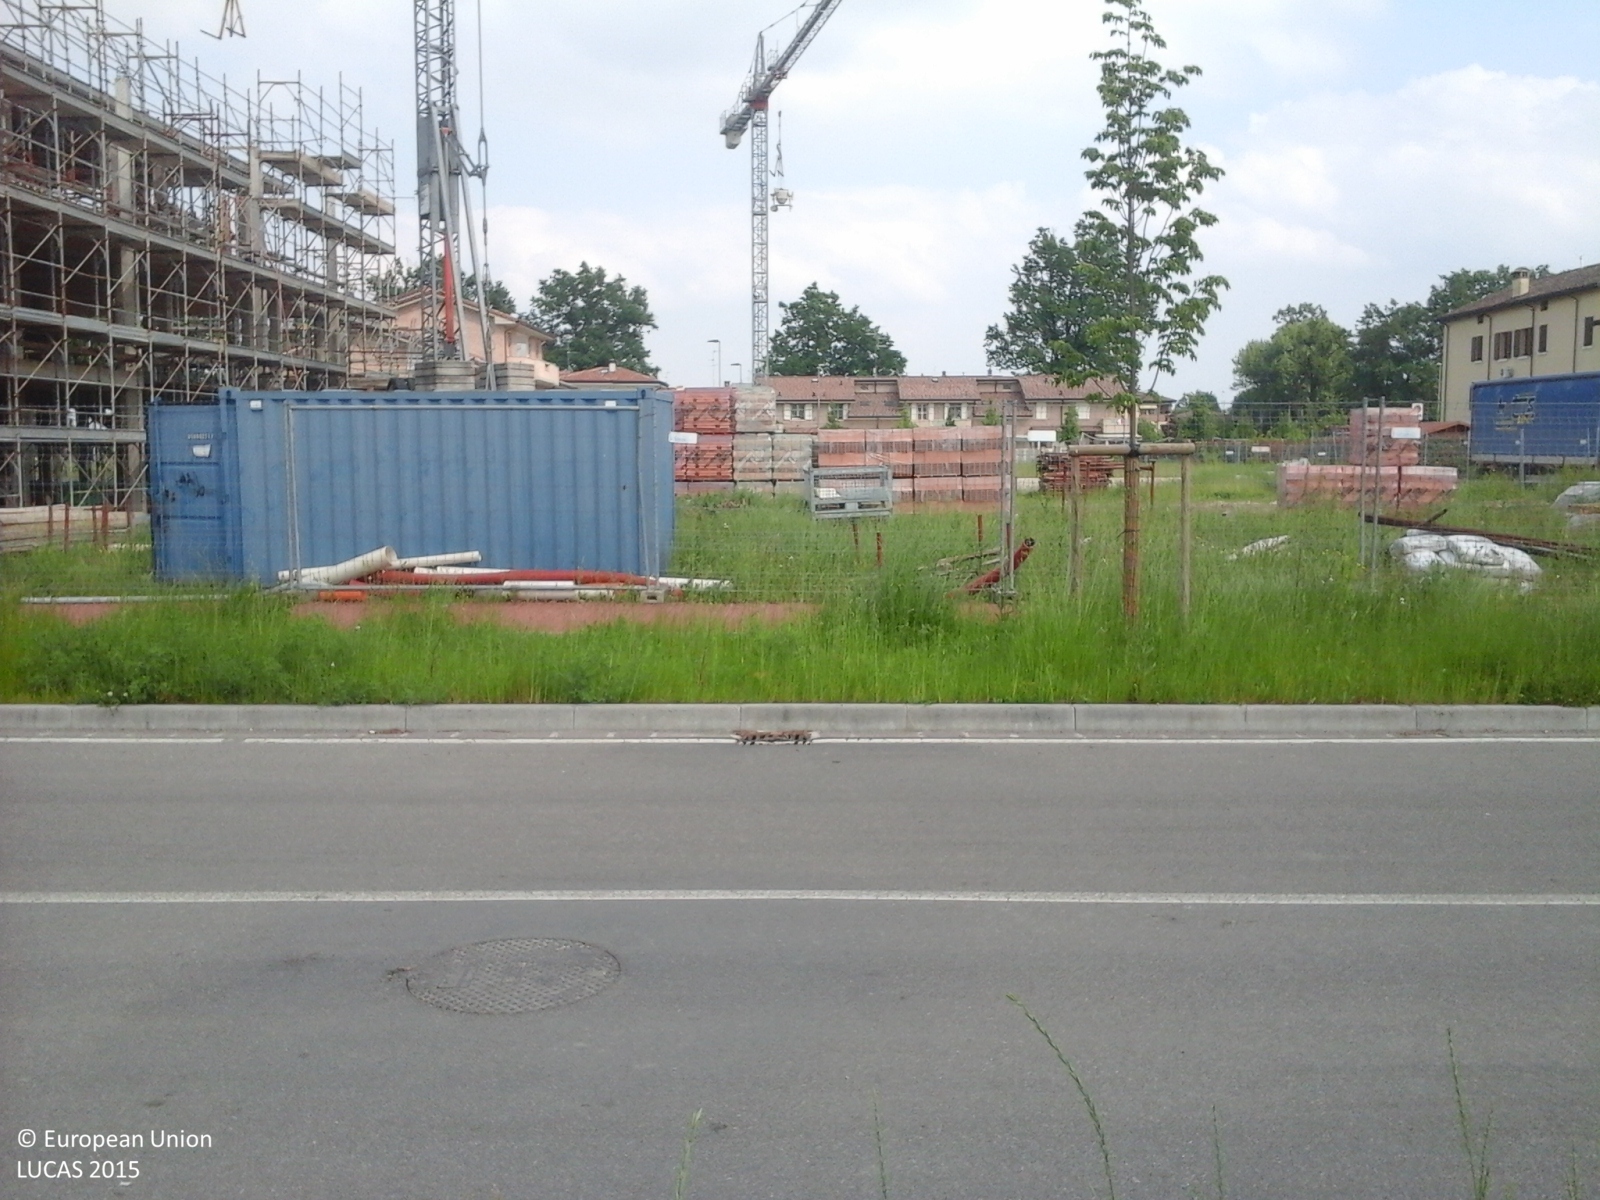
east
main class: Grassland
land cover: Spontaneously vegetated surfaces
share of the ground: 50 - 75 %
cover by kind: herbaceous plants 100 %
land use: Agriculture (excluding fallow land and kitchen gardens)
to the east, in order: Spontaneously vegetated surfaces; Artificial constructions in urban areas; Grassland without tree/shrub cover; Abandoned hedges; Ditches and canals; Common wheat
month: April
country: IT
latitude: 44.7795
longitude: 10.8954
